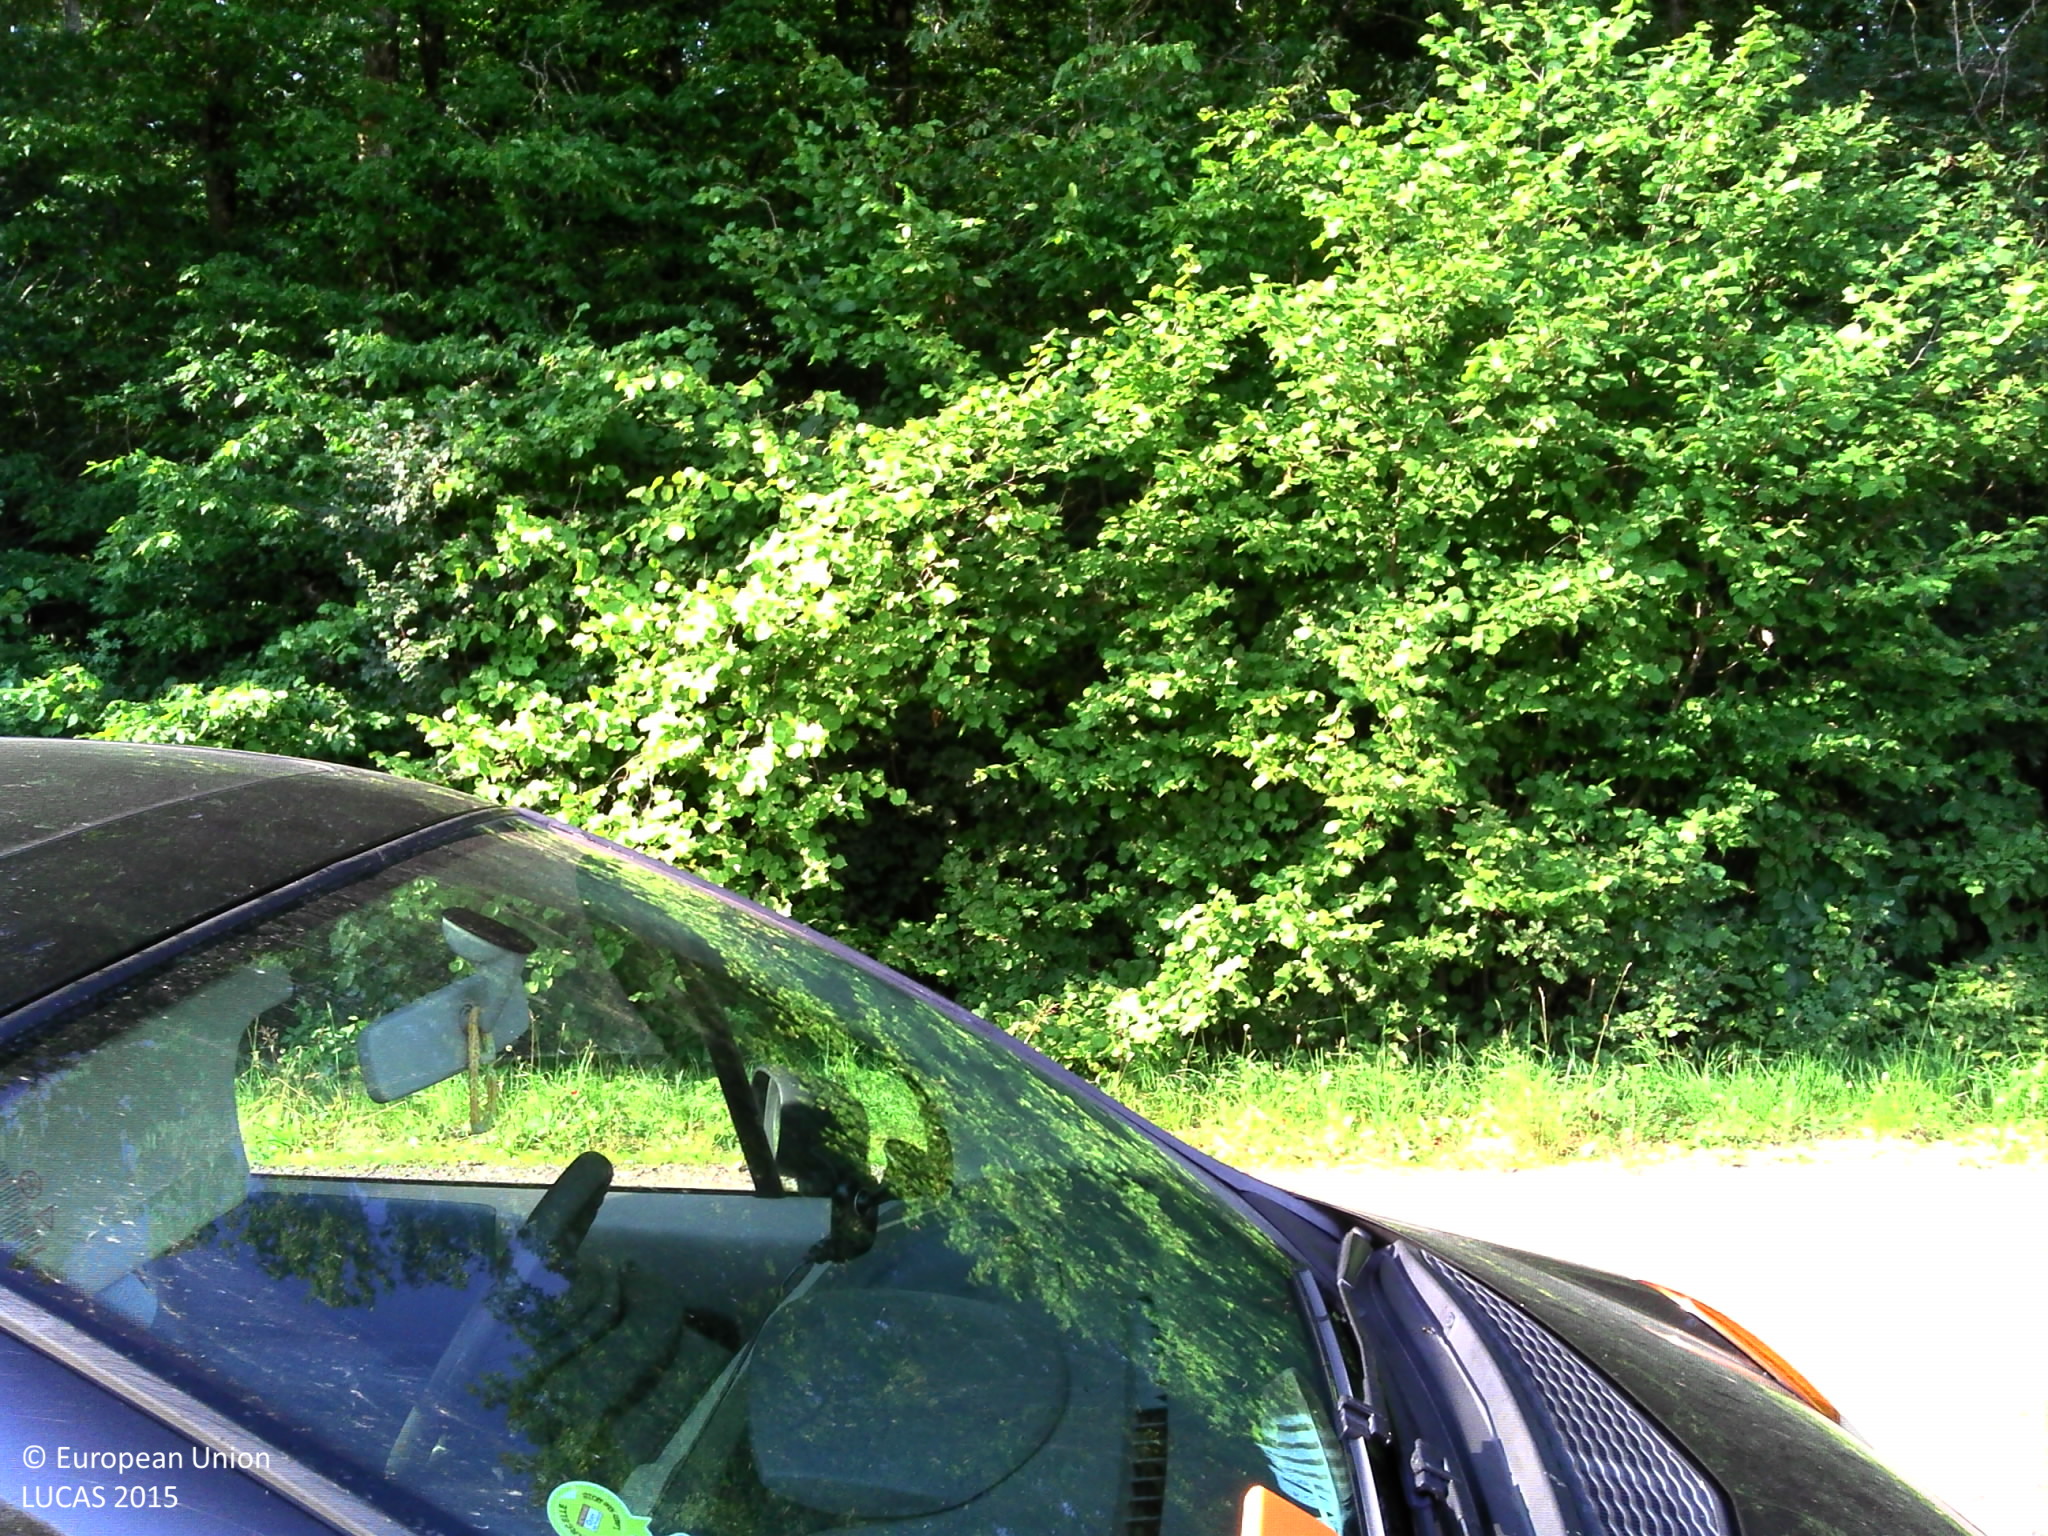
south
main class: Cropland
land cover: Rape and turnip rape
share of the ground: > 75 %
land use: Agriculture (excluding fallow land and kitchen gardens)
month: July
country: FR
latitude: 48.1383
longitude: 5.2287
